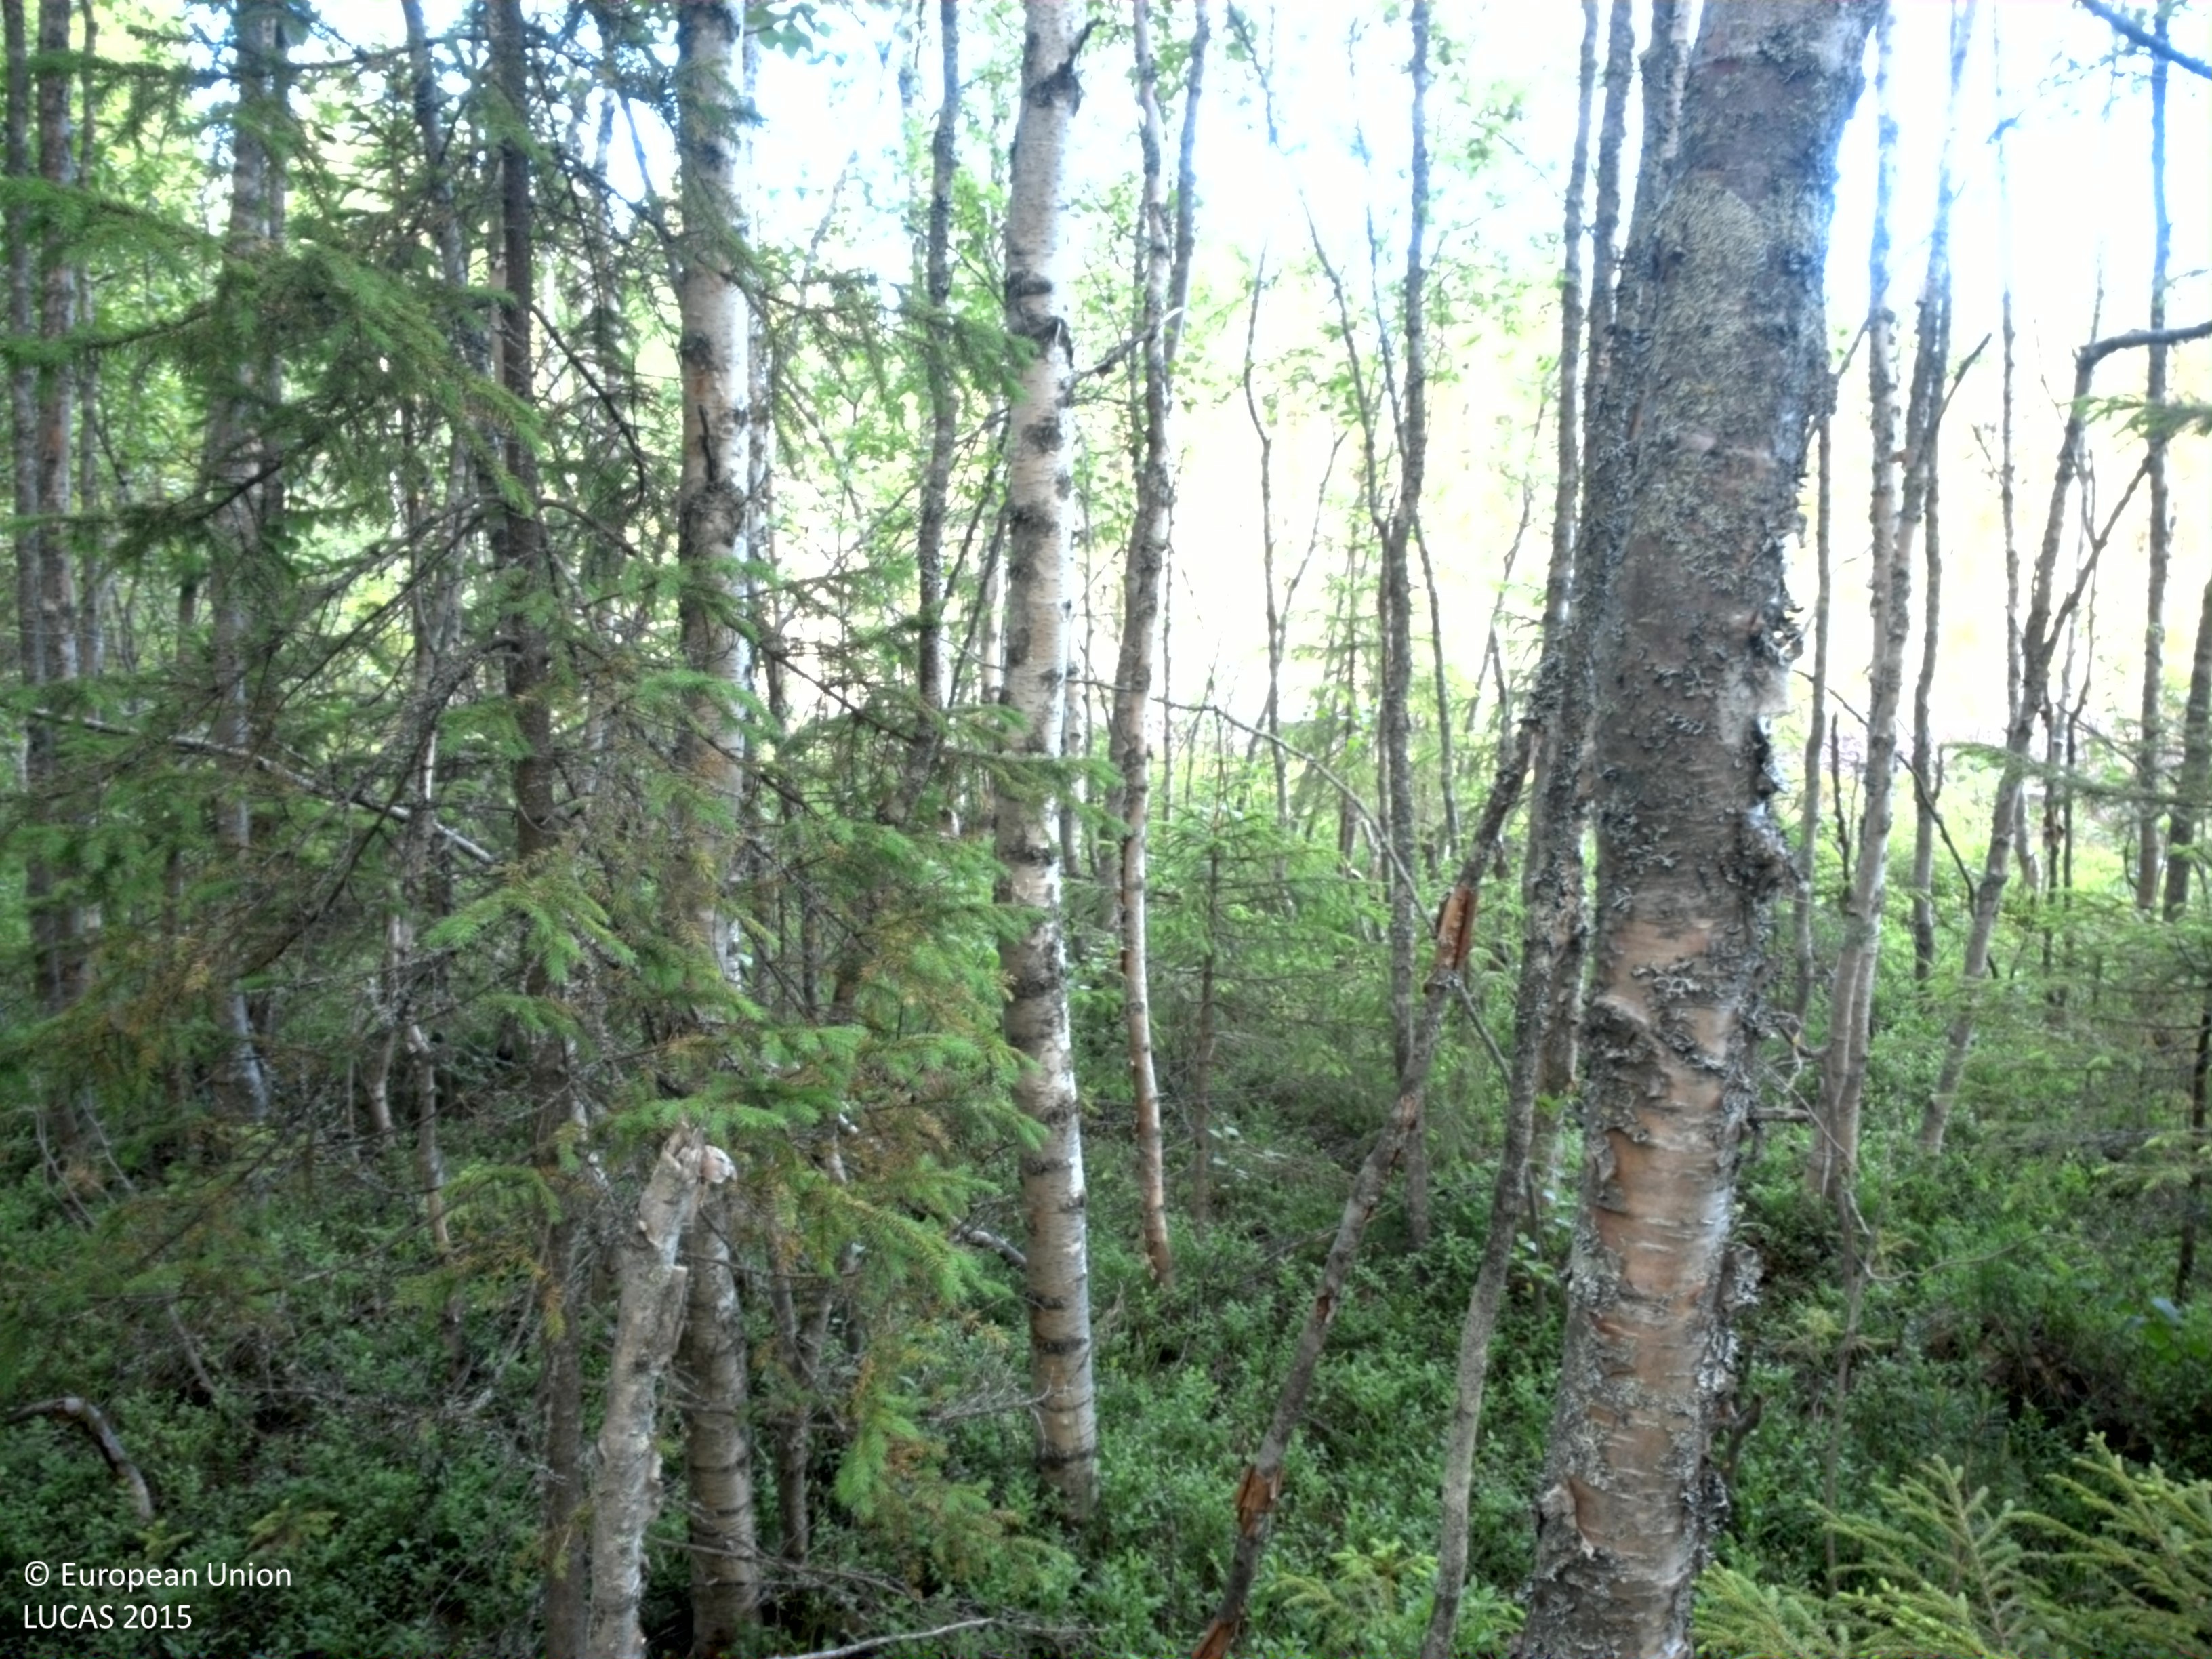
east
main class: Woodland
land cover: Spruce dominated mixed woodland
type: boreal forest
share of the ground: > 75 %
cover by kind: coniferous forest trees 50 %, broadleaved forest trees 35 %, shrubs 15 %
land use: Forestry
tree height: > 5 m
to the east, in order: Spruce dominated mixed woodland; Shrubland with sparse tree cover; Other bare soil; Grassland with sparse tree/shrub cover; Rivers and streams; Spruce dominated coniferous woodland; Ditches and canals; Spruce dominated coniferous woodland; Other mixed woodland; Other coniferous woodland
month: June
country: SE
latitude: 64.2527
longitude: 20.7306
